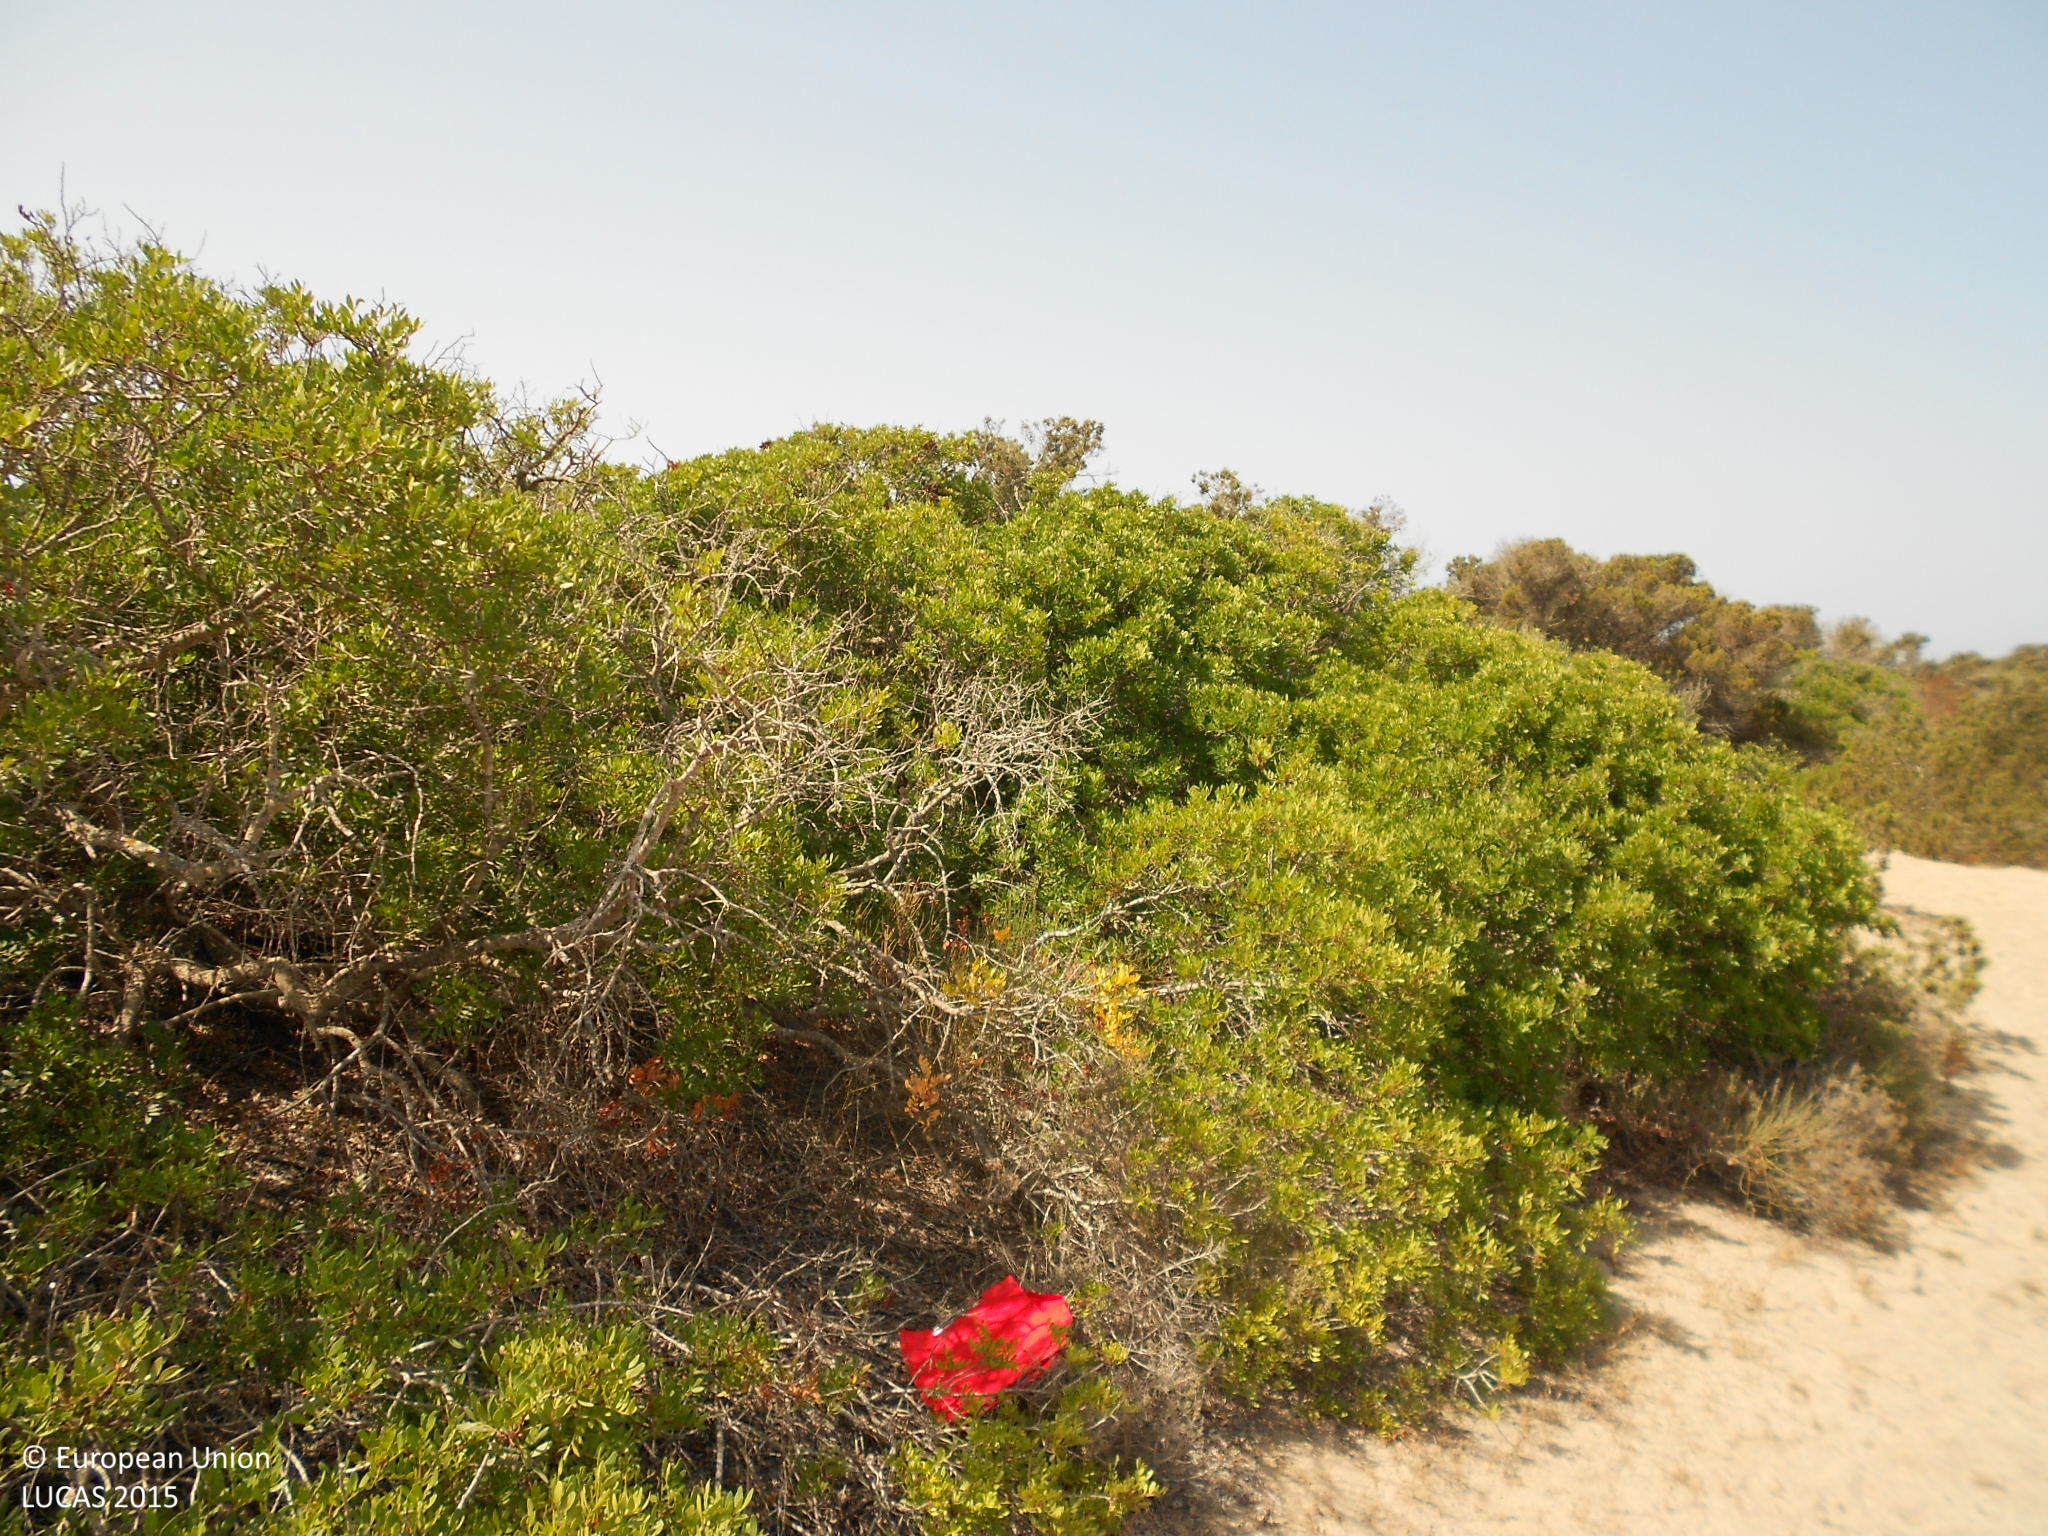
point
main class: Shrubland
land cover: Shrubland without tree cover
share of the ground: 50 - 75 %
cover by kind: shrubs 60 %, unconsolidated bare surface 40 %
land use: Semi-natural and natural areas not in use
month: August
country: ES
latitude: 36.6906
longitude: -2.6995
